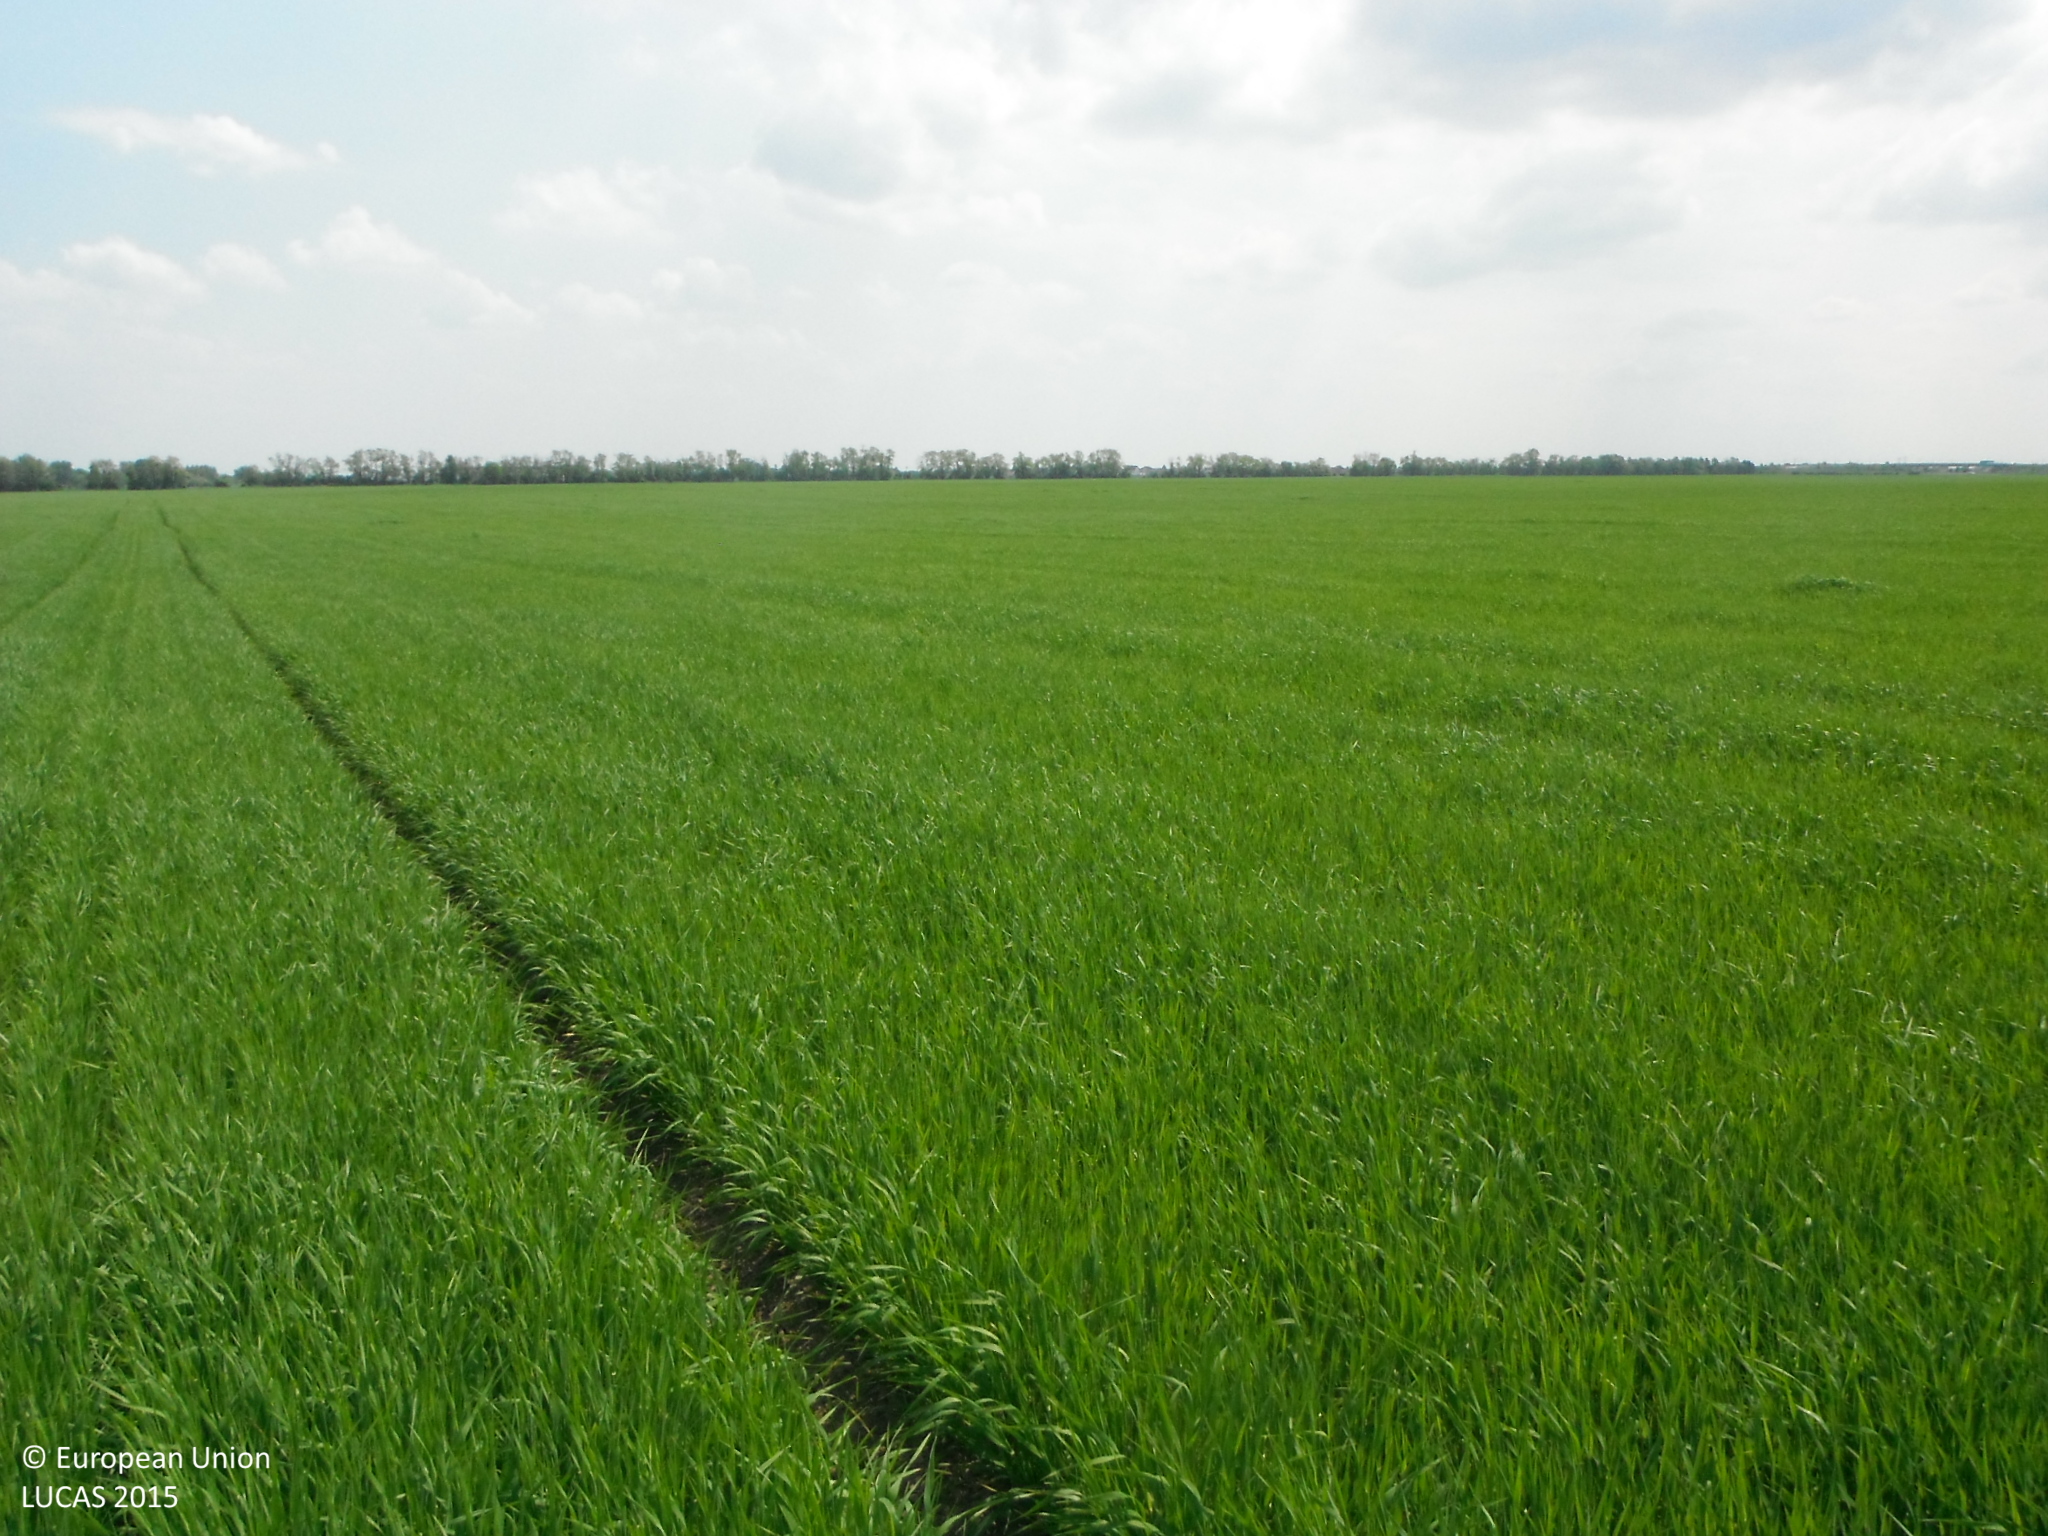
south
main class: Cropland
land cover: Common wheat
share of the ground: > 75 %
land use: Agriculture (excluding fallow land and kitchen gardens)
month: May
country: SK
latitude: 48.0842
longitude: 17.1093
